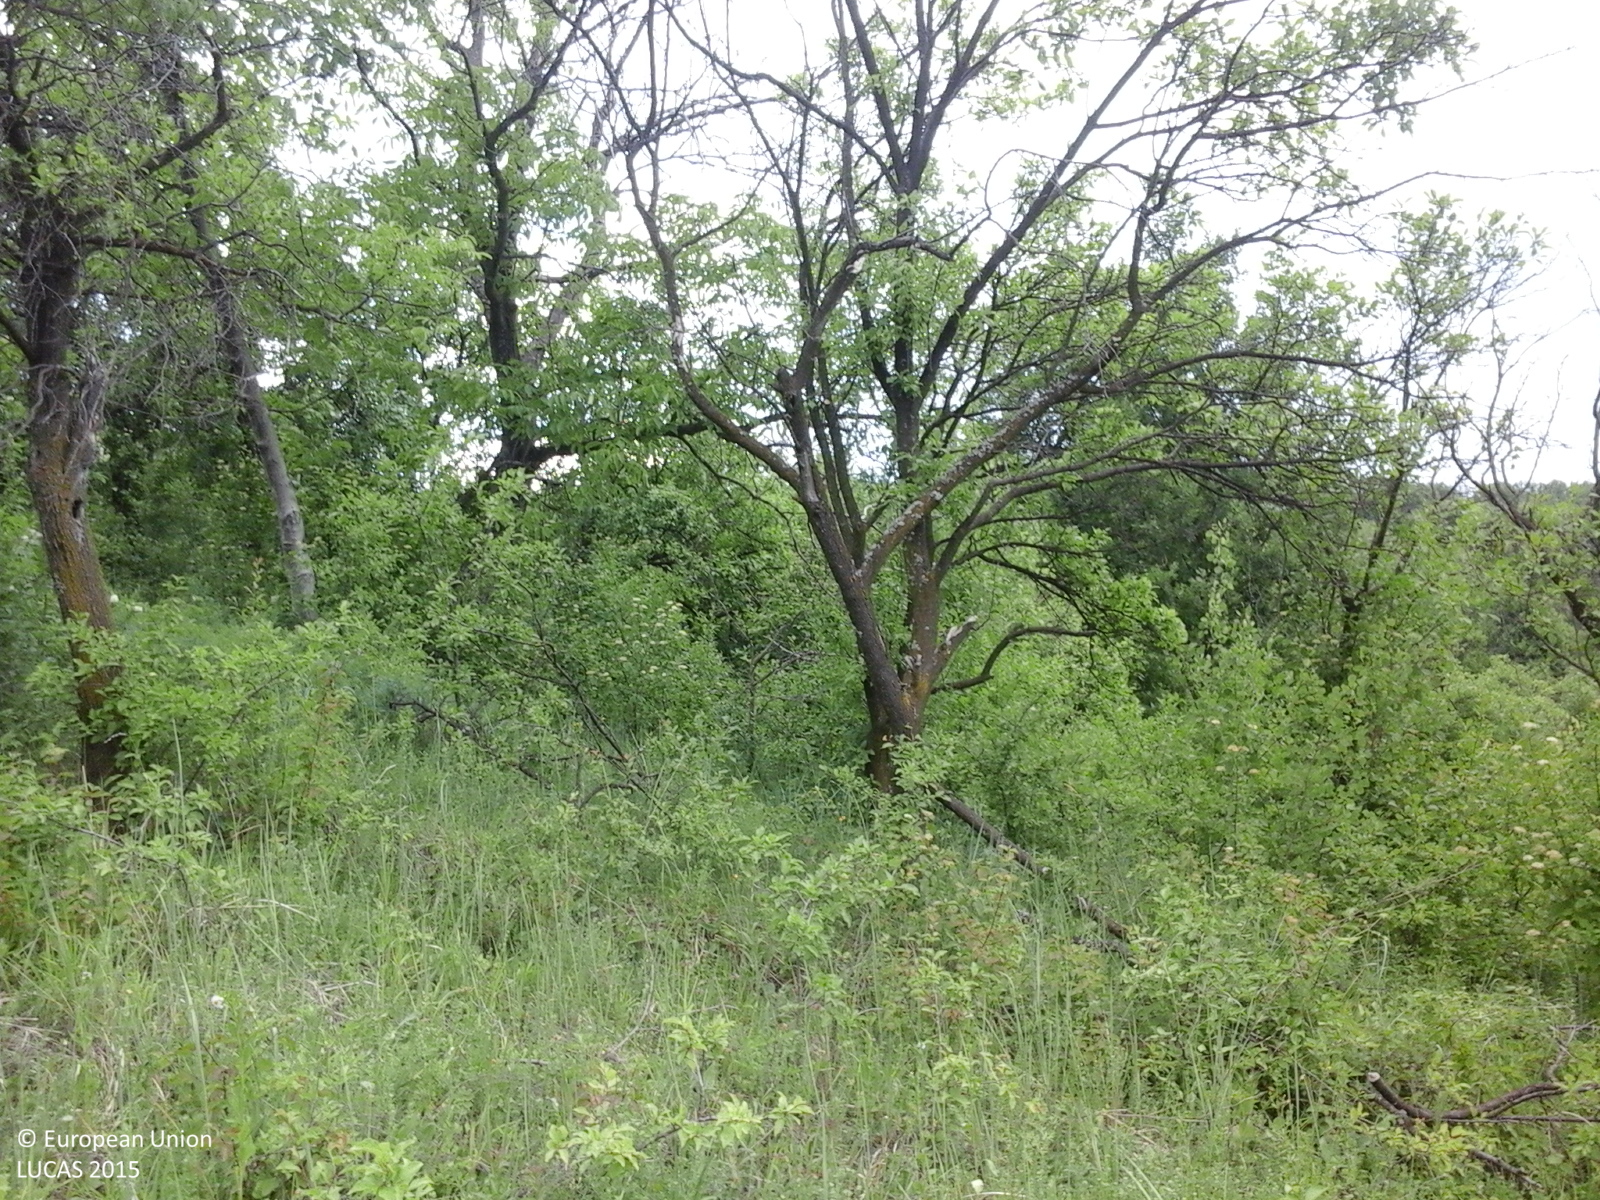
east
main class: Grassland
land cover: Grassland with sparse tree/shrub cover
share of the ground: > 75 %
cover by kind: herbaceous plants 90 %, broadleaved forest trees 5 %, shrubs 5 %
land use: Forestry
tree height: < 5 m
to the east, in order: Grassland with sparse tree/shrub cover; Broadleaved woodland; Vineyards; Other fruit trees and berries; Abandoned hedges; Vineyards; Abandoned hedges; Vineyards; Broadleaved woodland; Tracks; Broadleaved woodland
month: June
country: RO
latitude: 46.3540
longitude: 26.7881
